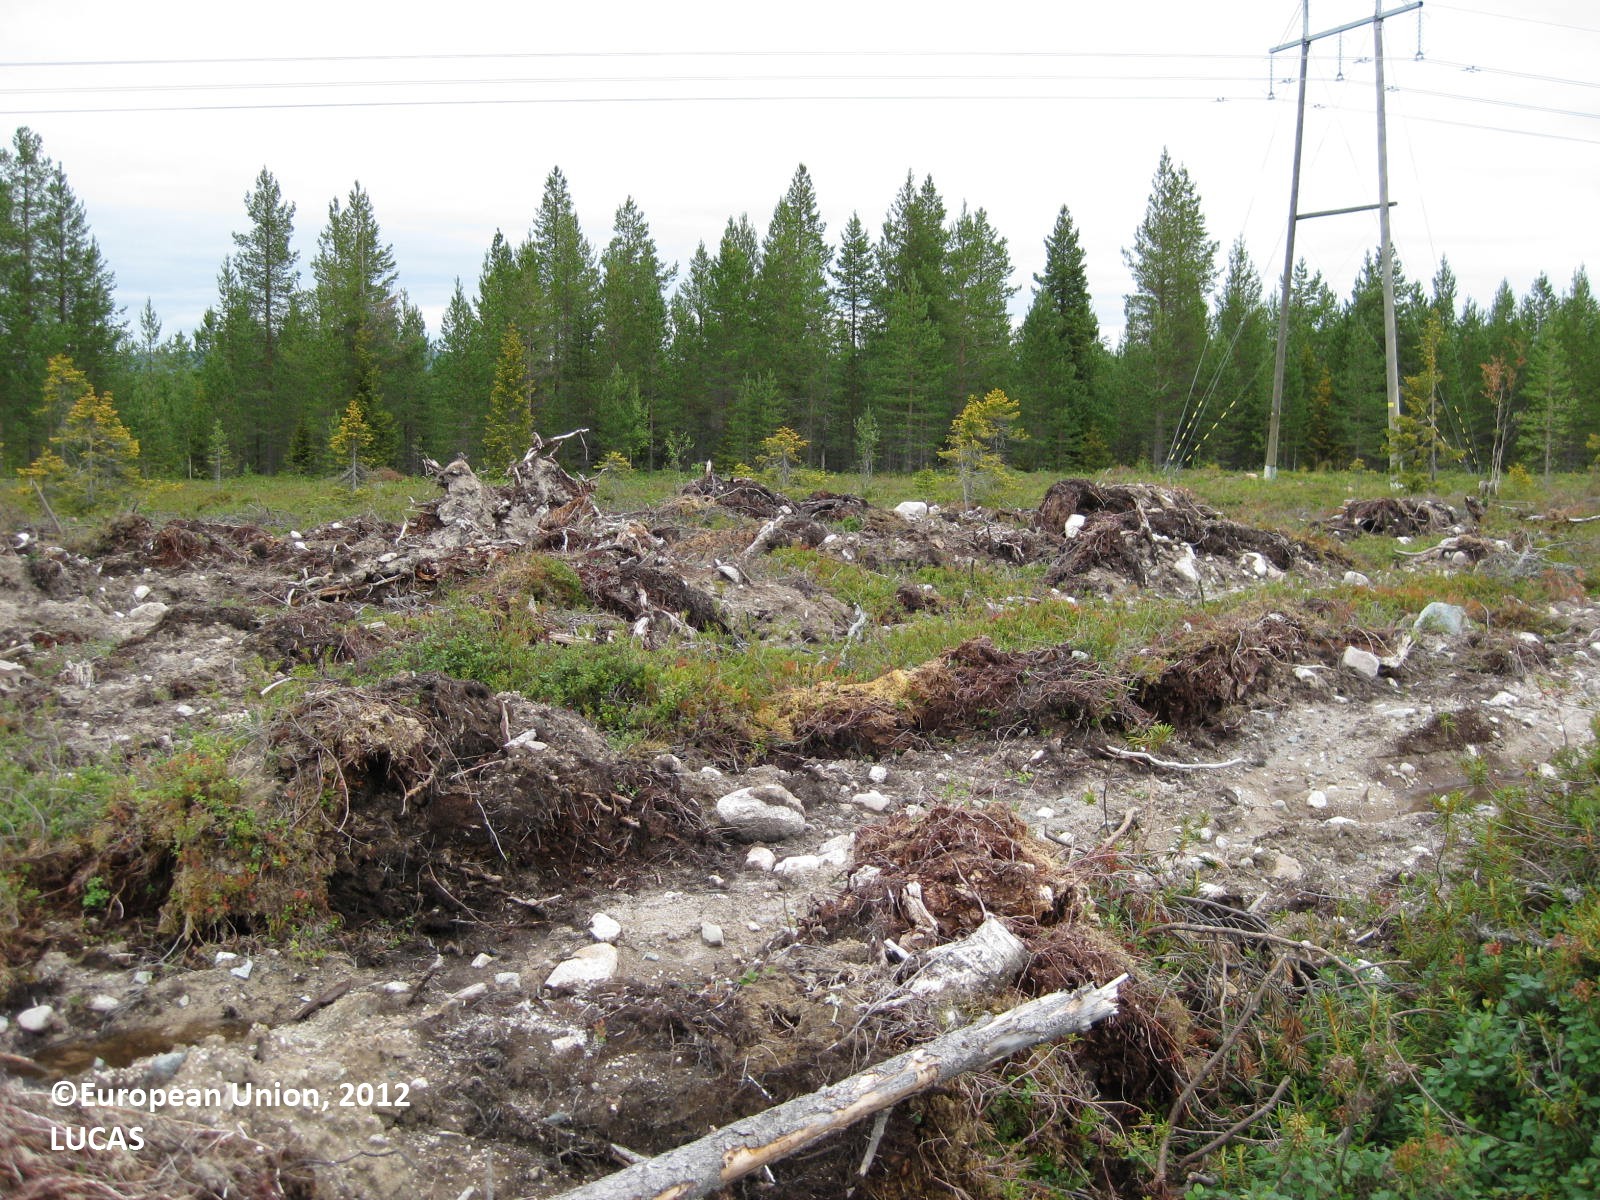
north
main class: Shrubland
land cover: Shrubland without tree cover
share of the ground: 10 - 25 %
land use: Forestry
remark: Clear cut
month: August
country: FI
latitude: 66.0279
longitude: 28.2999
